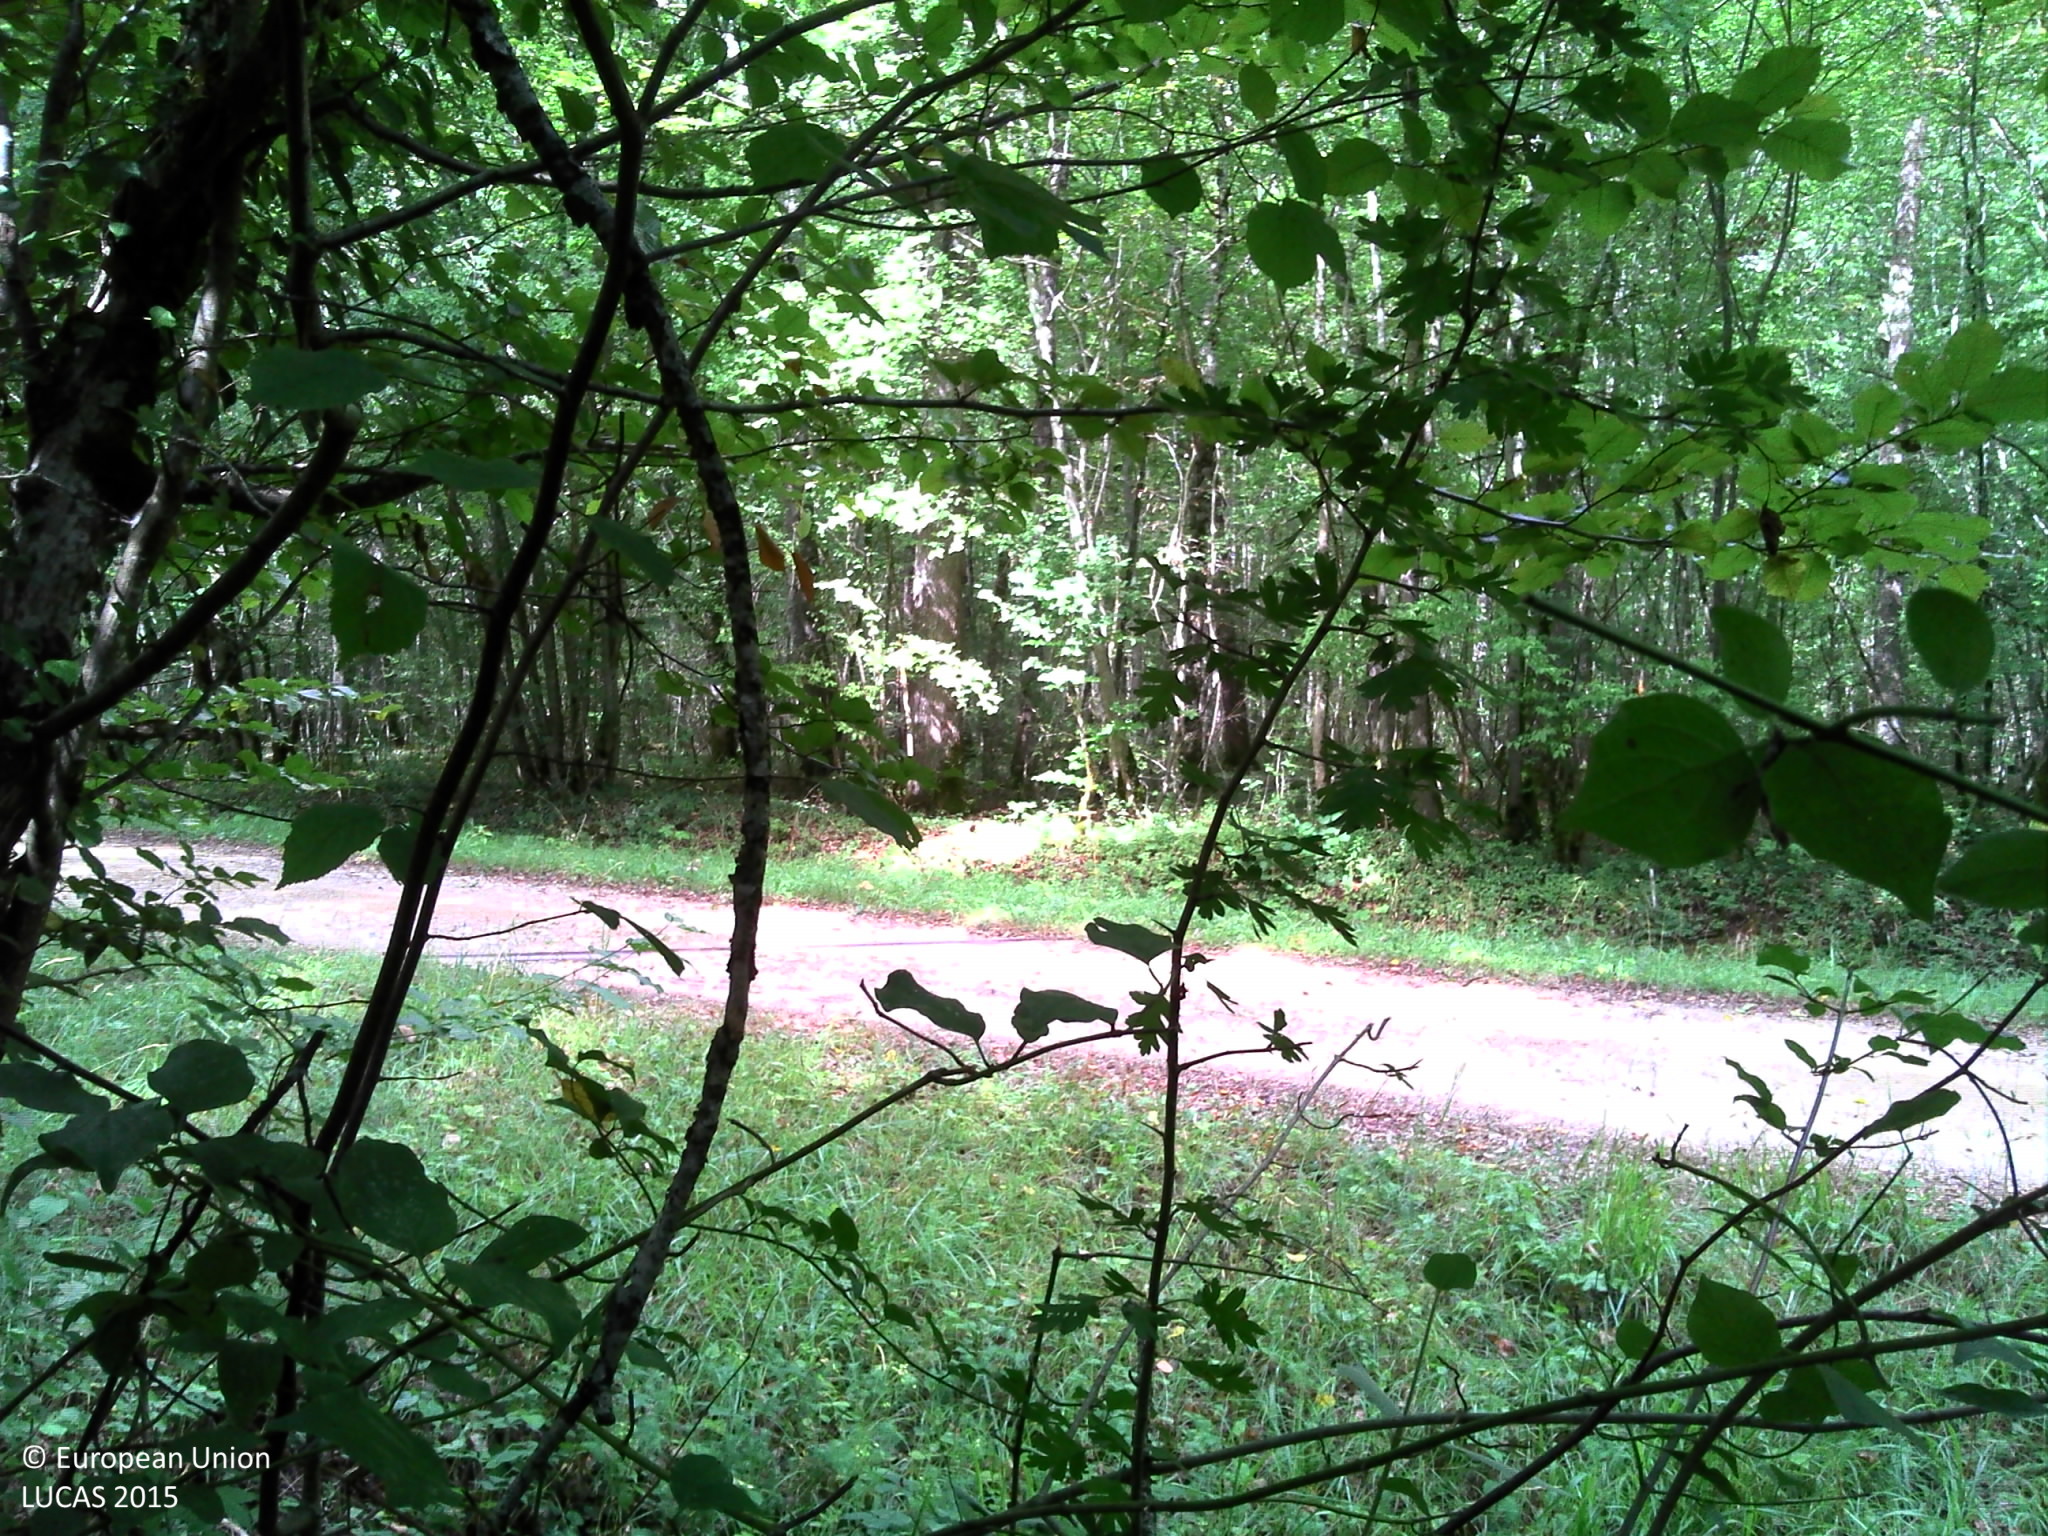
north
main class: Woodland
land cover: Broadleaved woodland
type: mesophytic deciduous forest
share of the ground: > 75 %
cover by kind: broadleaved forest trees 85 %, shrubs 5 %, herbaceous plants 5 %, lichens and mosses 5 %
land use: Forestry
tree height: > 5 m
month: August
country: FR
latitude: 47.9035
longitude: 4.8218
